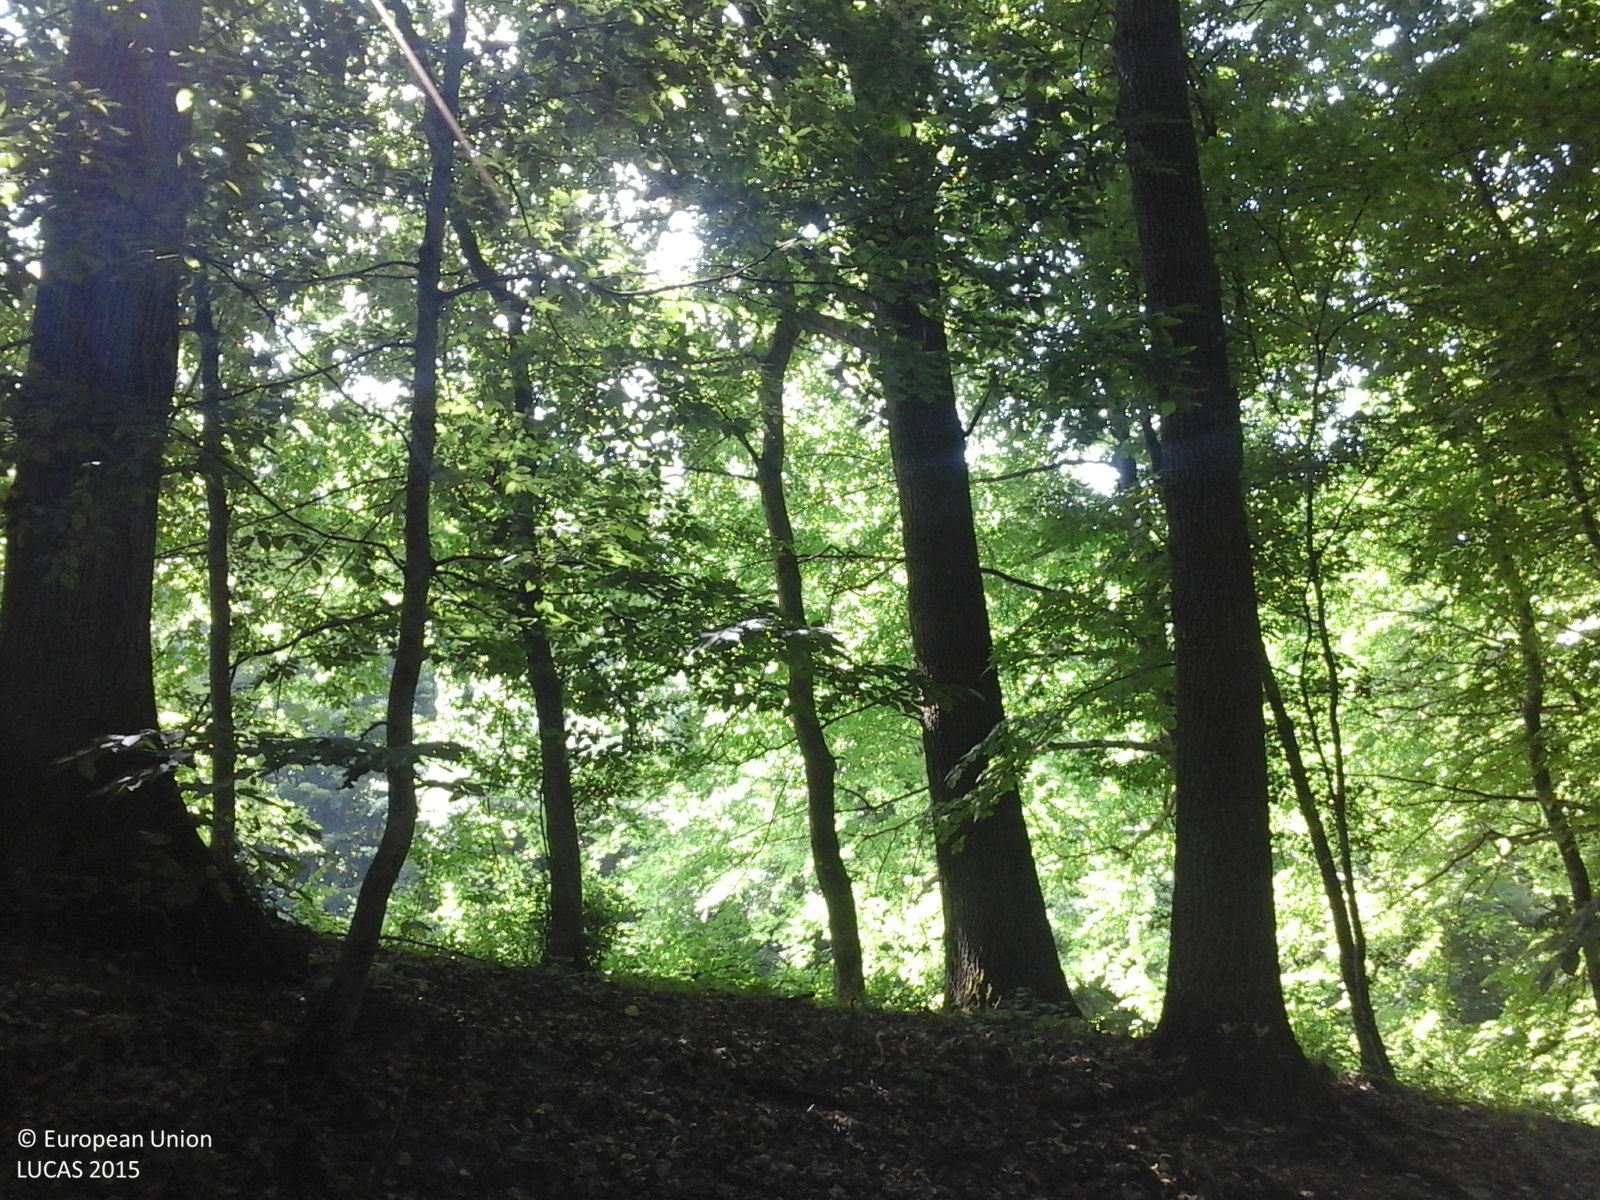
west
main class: Woodland
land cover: Broadleaved woodland
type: beech forest
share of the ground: > 75 %
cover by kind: broadleaved forest trees 100 %
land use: Forestry
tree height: > 5 m
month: June
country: RO
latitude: 47.3774
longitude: 26.8250
